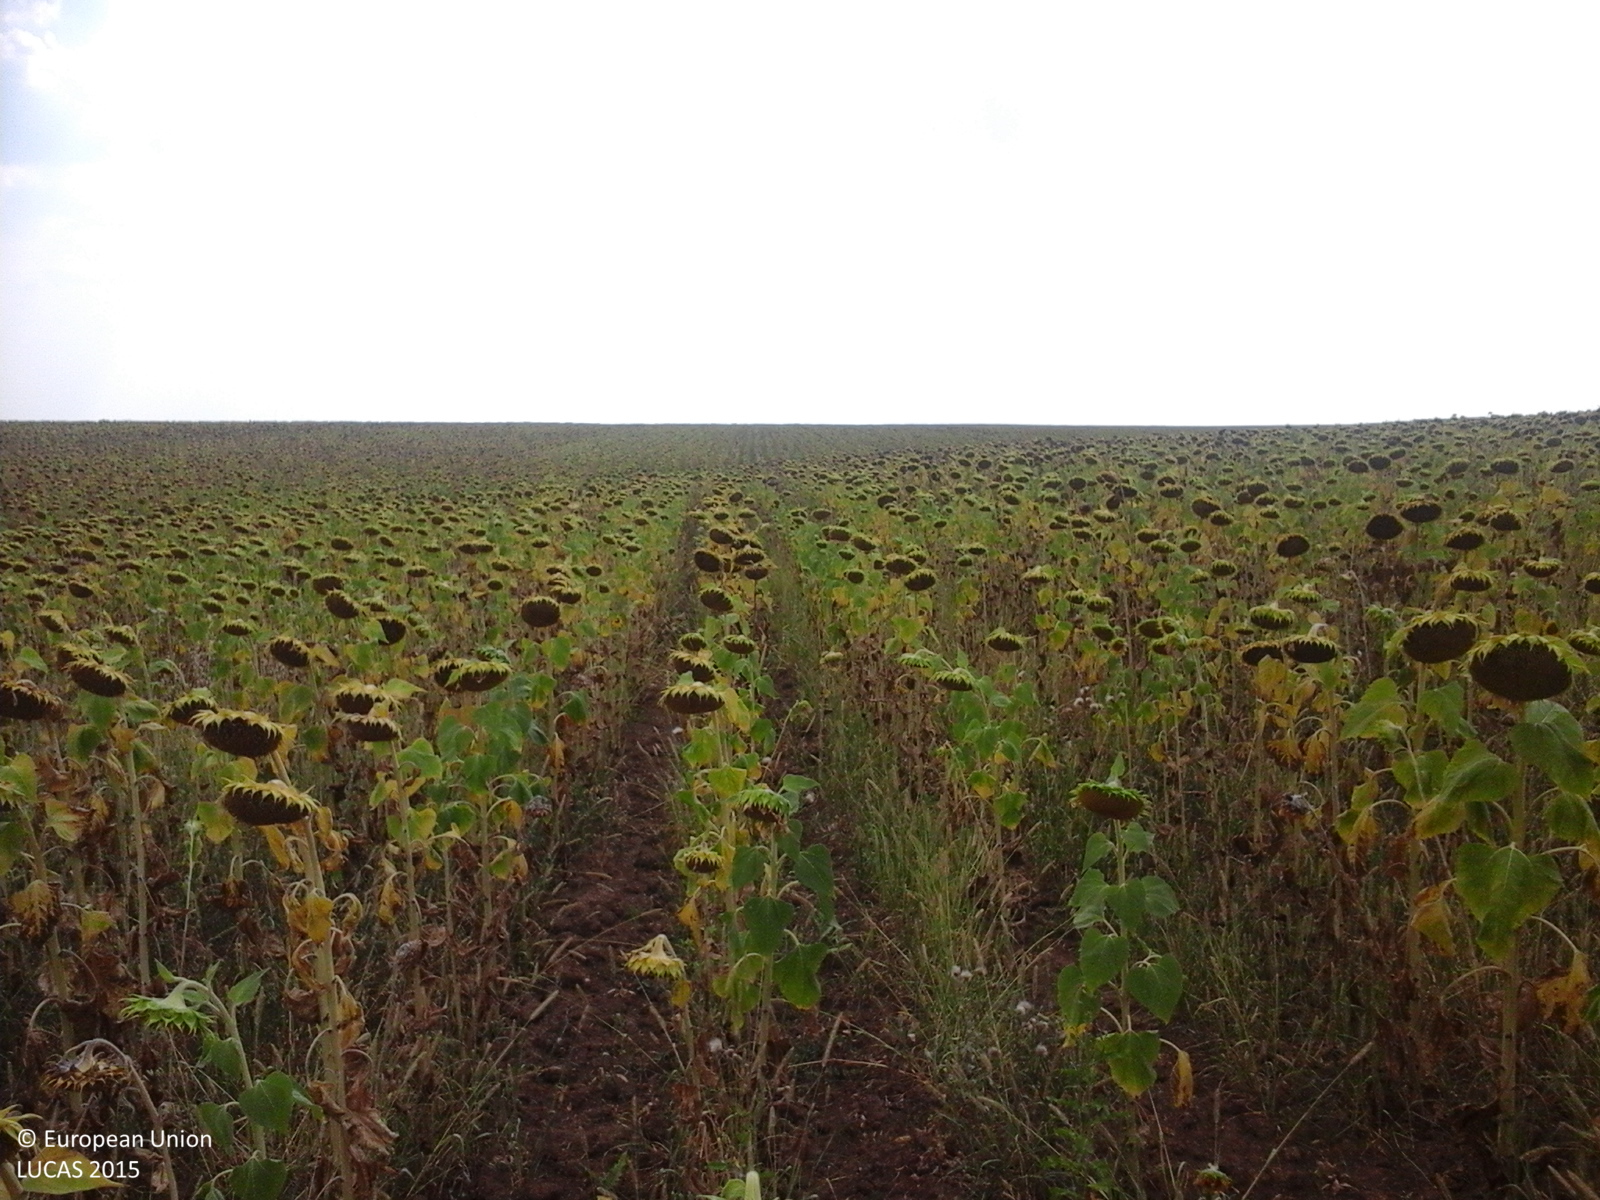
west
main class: Cropland
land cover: Sunflower
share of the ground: > 75 %
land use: Agriculture (excluding fallow land and kitchen gardens)
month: August
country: RO
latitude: 44.3517
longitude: 23.1309
